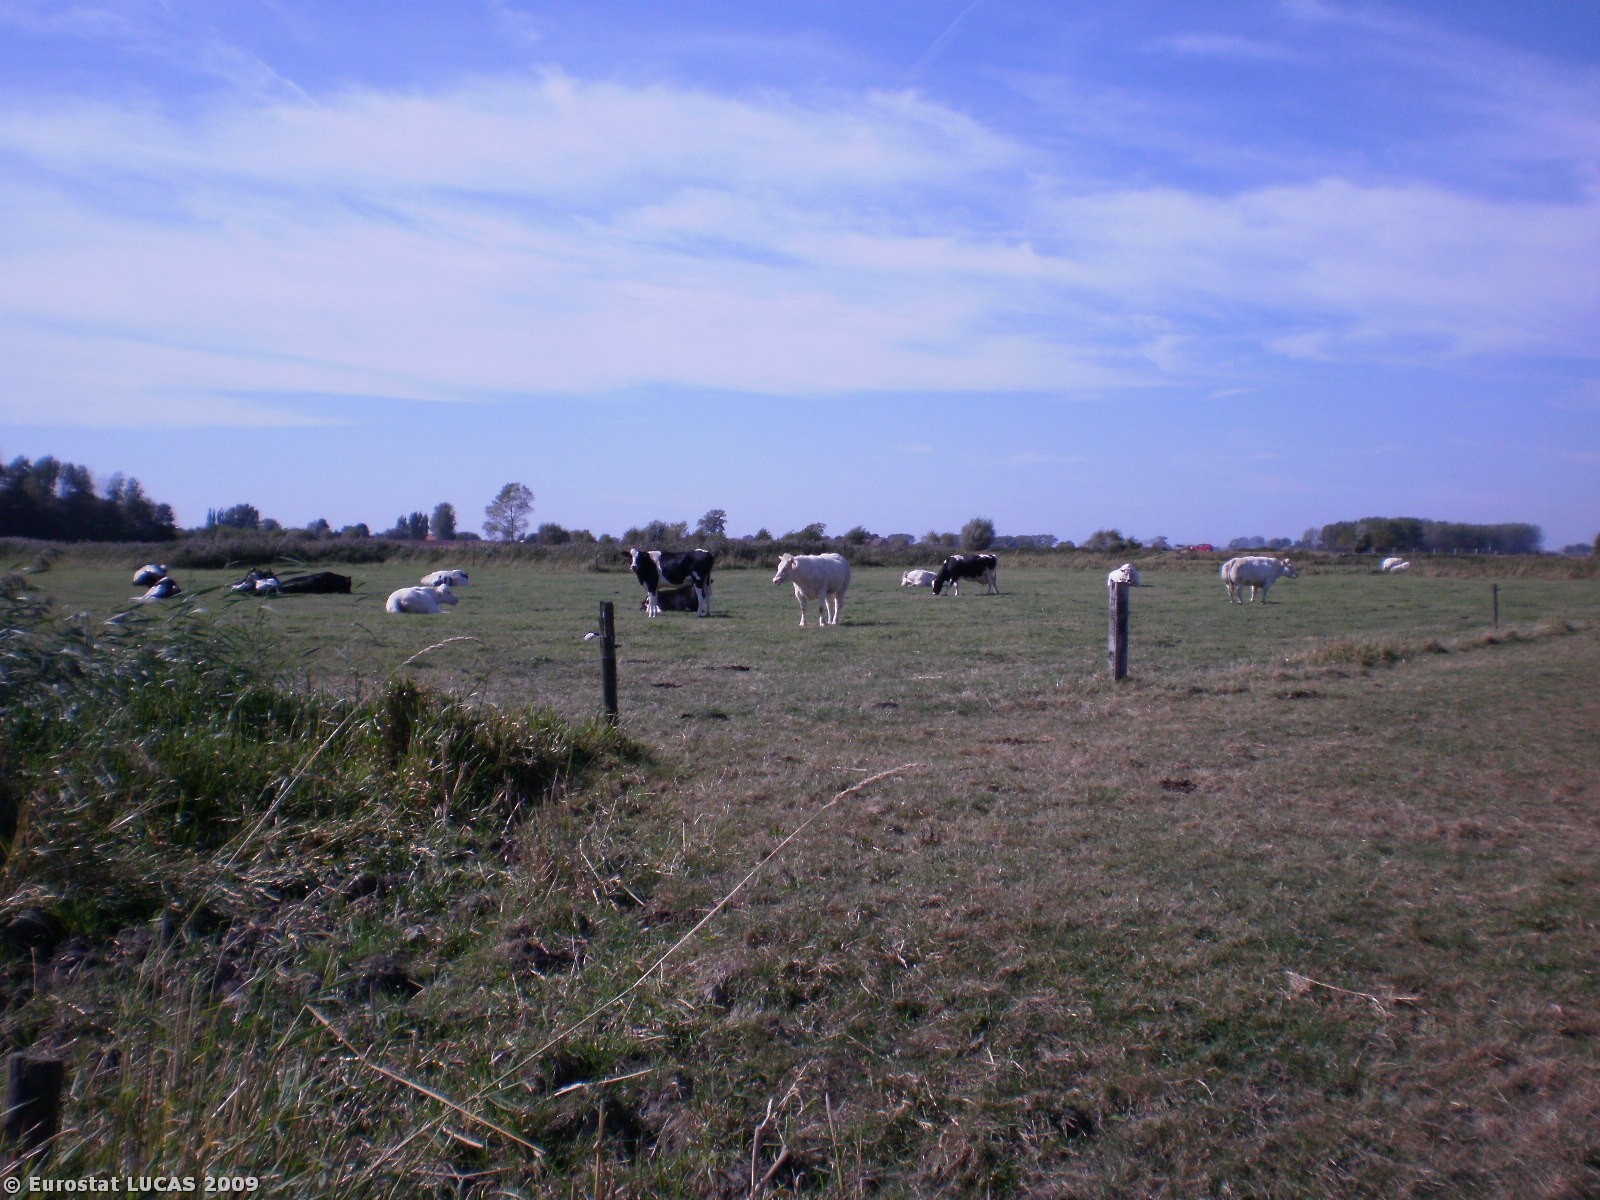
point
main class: Grassland
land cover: Grassland without tree/shrub cover
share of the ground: > 75 %
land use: Agriculture (excluding fallow land and kitchen gardens)
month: September
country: BE
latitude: 50.9494
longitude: 2.8006
